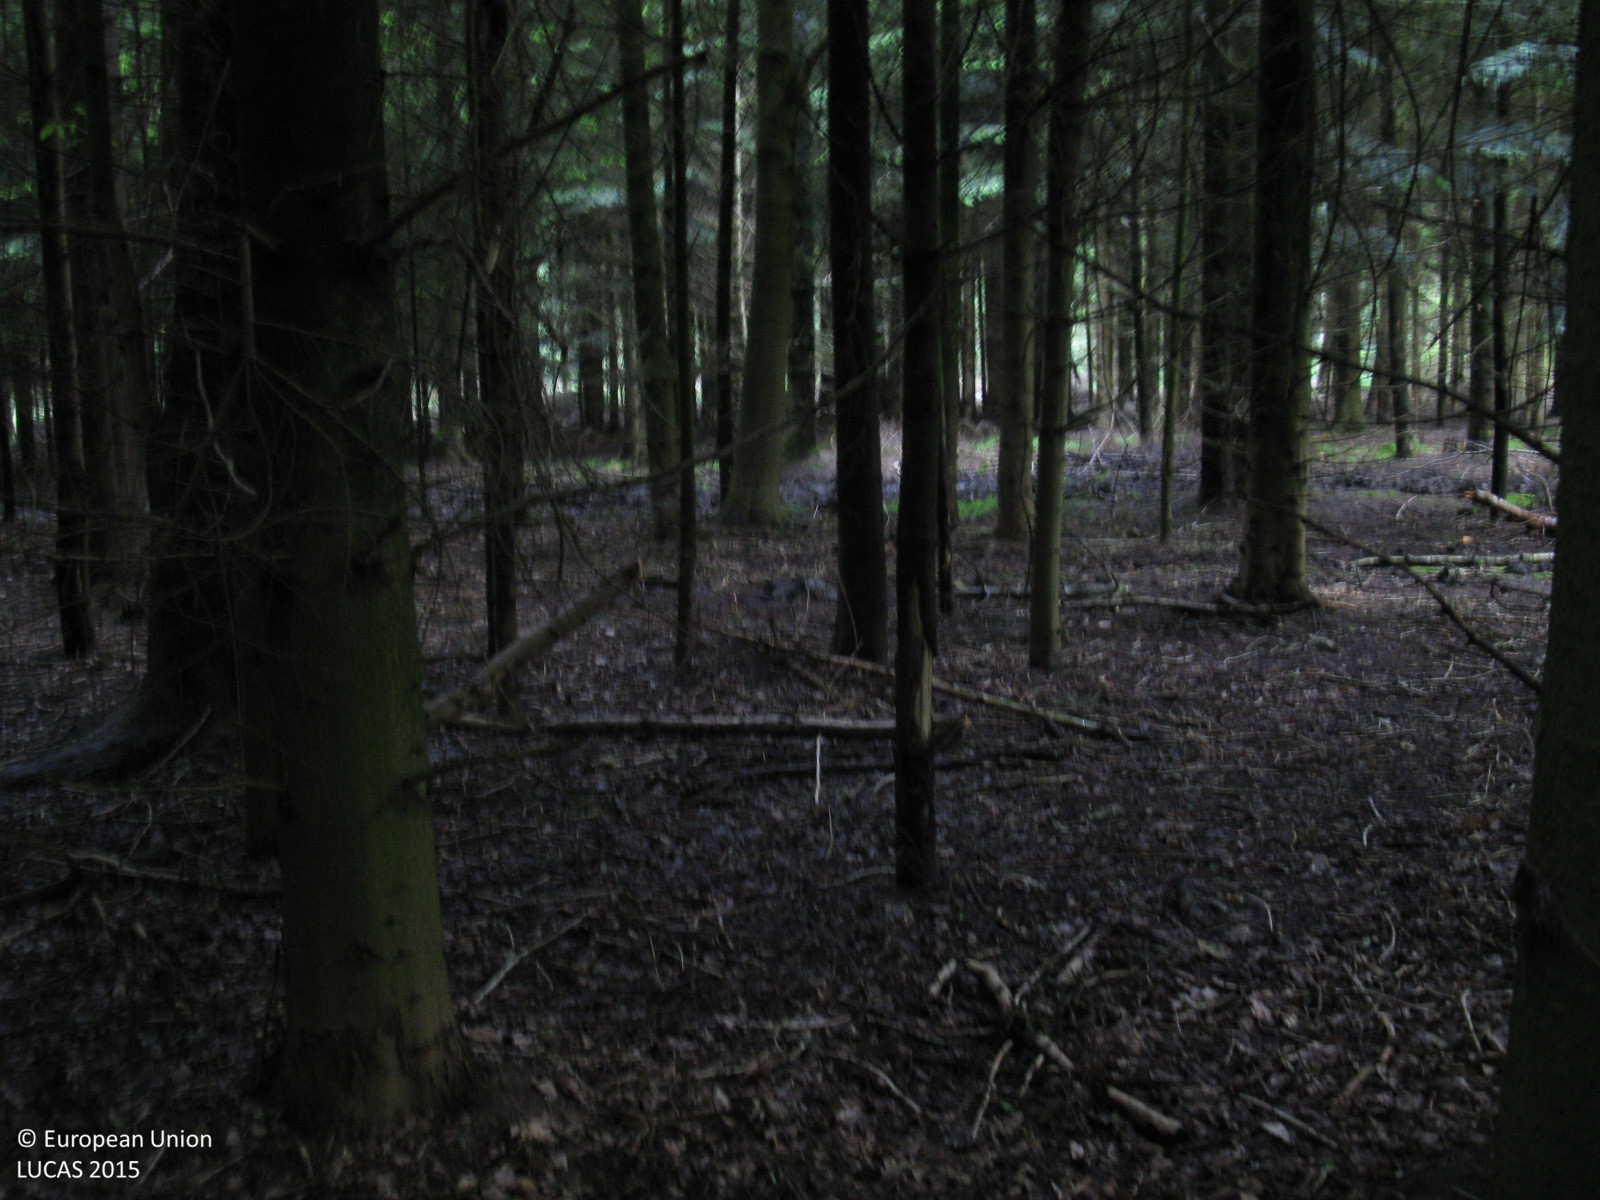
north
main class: Woodland
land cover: Spruce dominated mixed woodland
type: hemiboreal forest and nemoral coniferous forest and mixed broadleaved-coniferous forest
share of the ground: > 75 %
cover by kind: coniferous forest trees 70 %, broadleaved forest trees 30 %
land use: Forestry
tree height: > 5 m
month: June
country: DE
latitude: 53.6228
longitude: 7.2641
